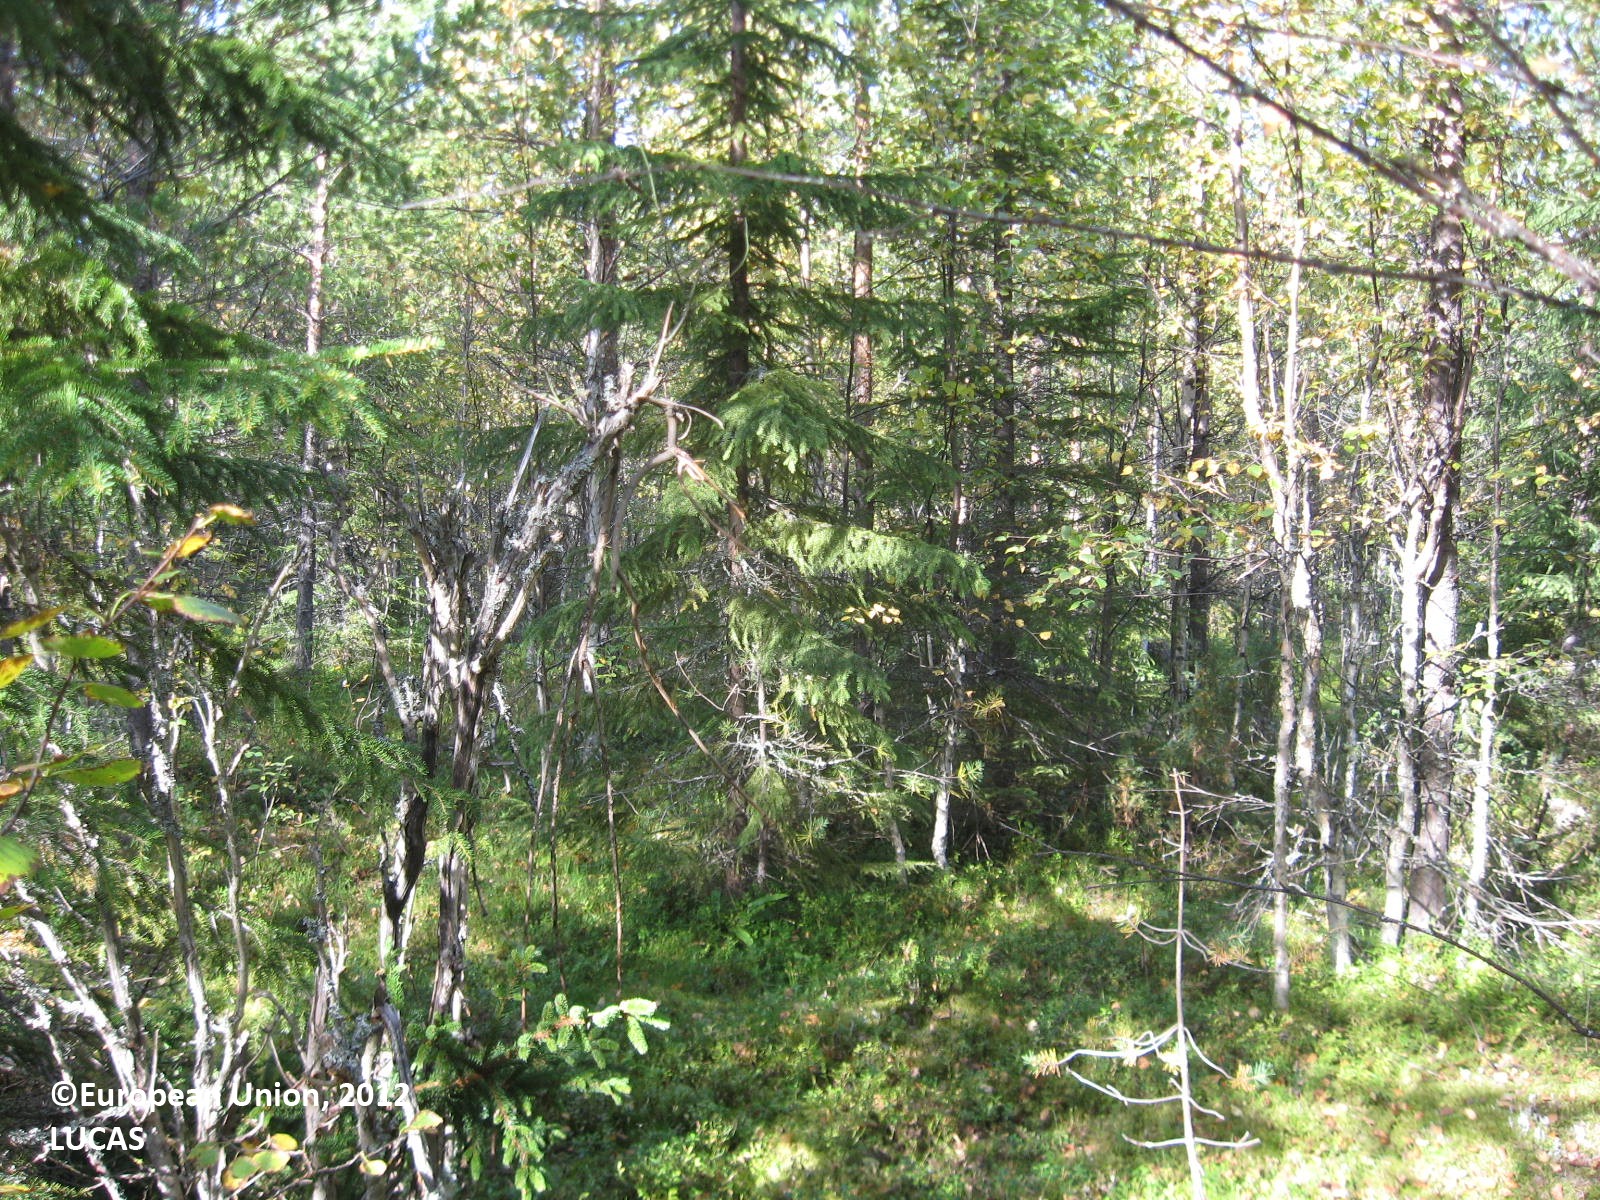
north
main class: Woodland
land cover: Other mixed woodland
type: boreal forest
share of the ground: > 75 %
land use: Forestry
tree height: > 5 m
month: August
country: FI
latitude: 63.8858
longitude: 28.7014
